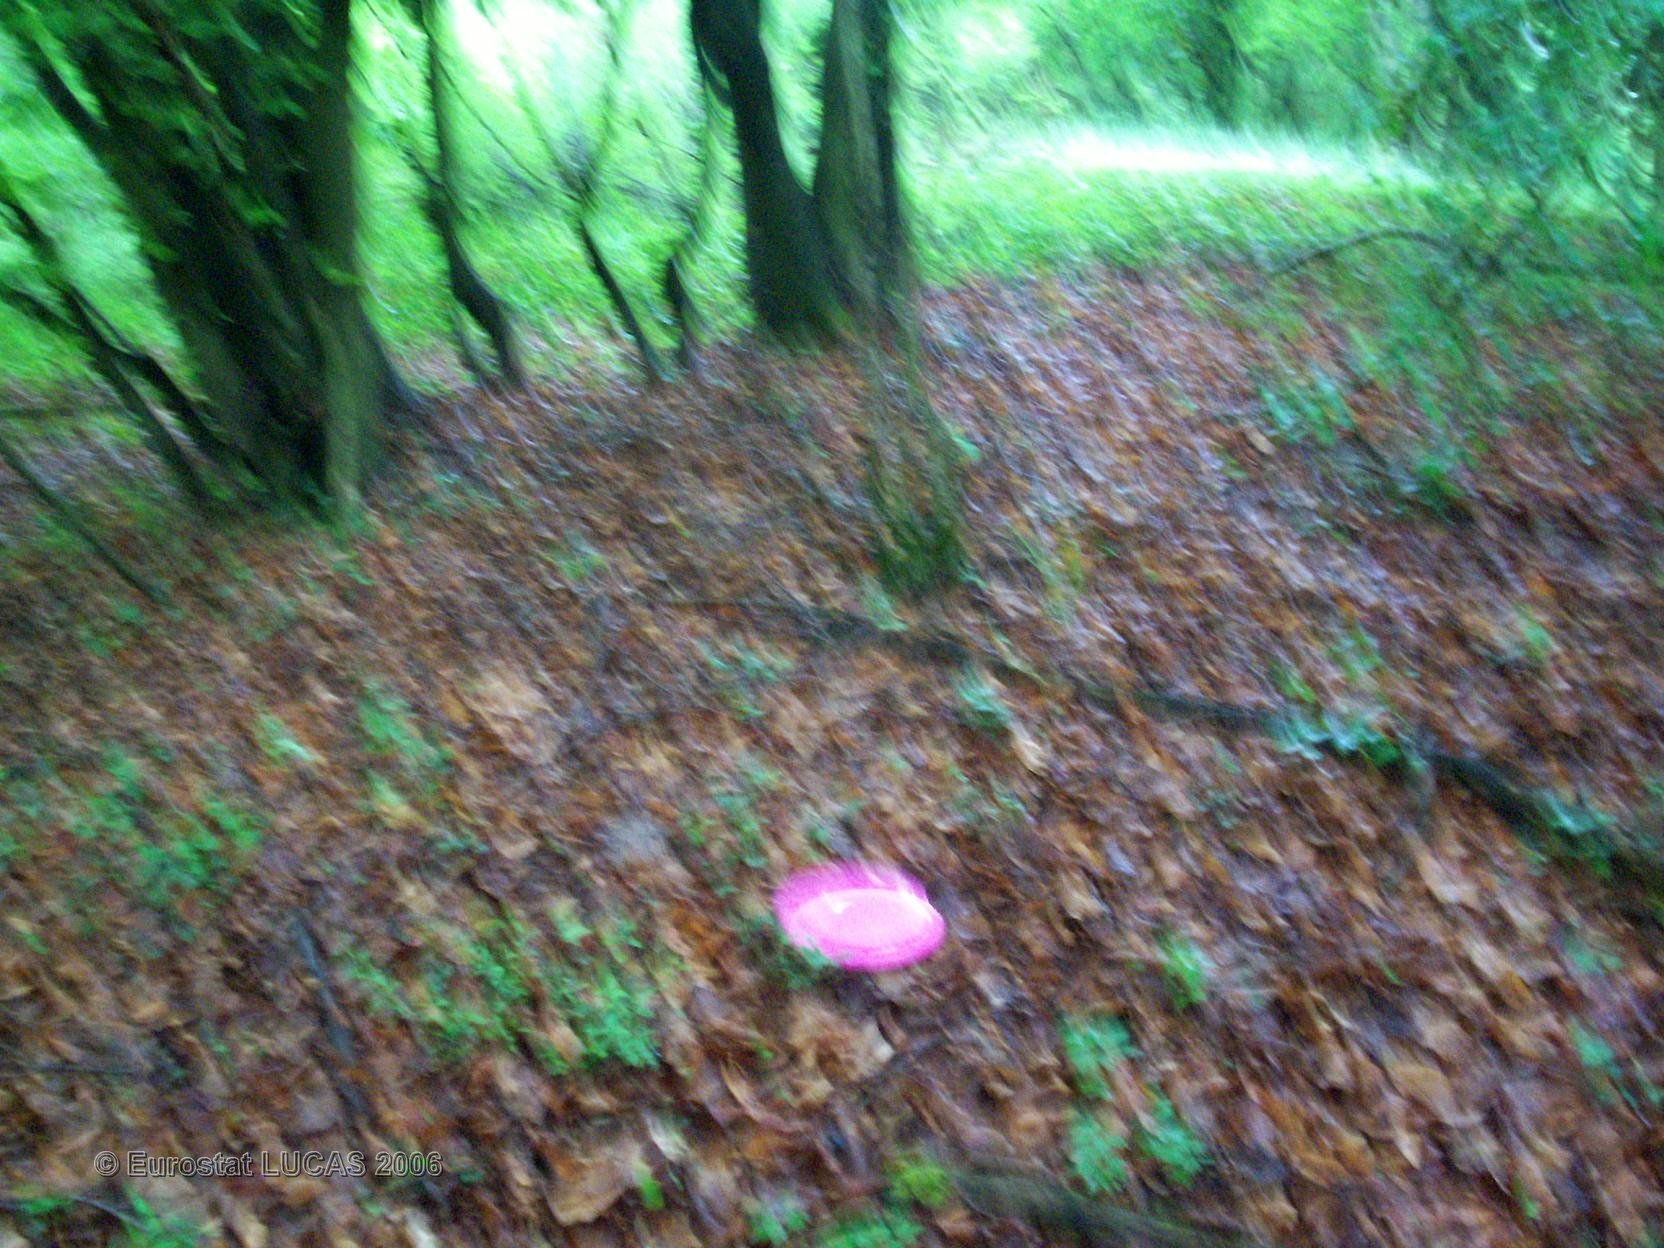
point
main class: Woodland
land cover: Broadleaved forest
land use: Forestry
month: May
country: FR
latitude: 49.3176
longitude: 6.4093
